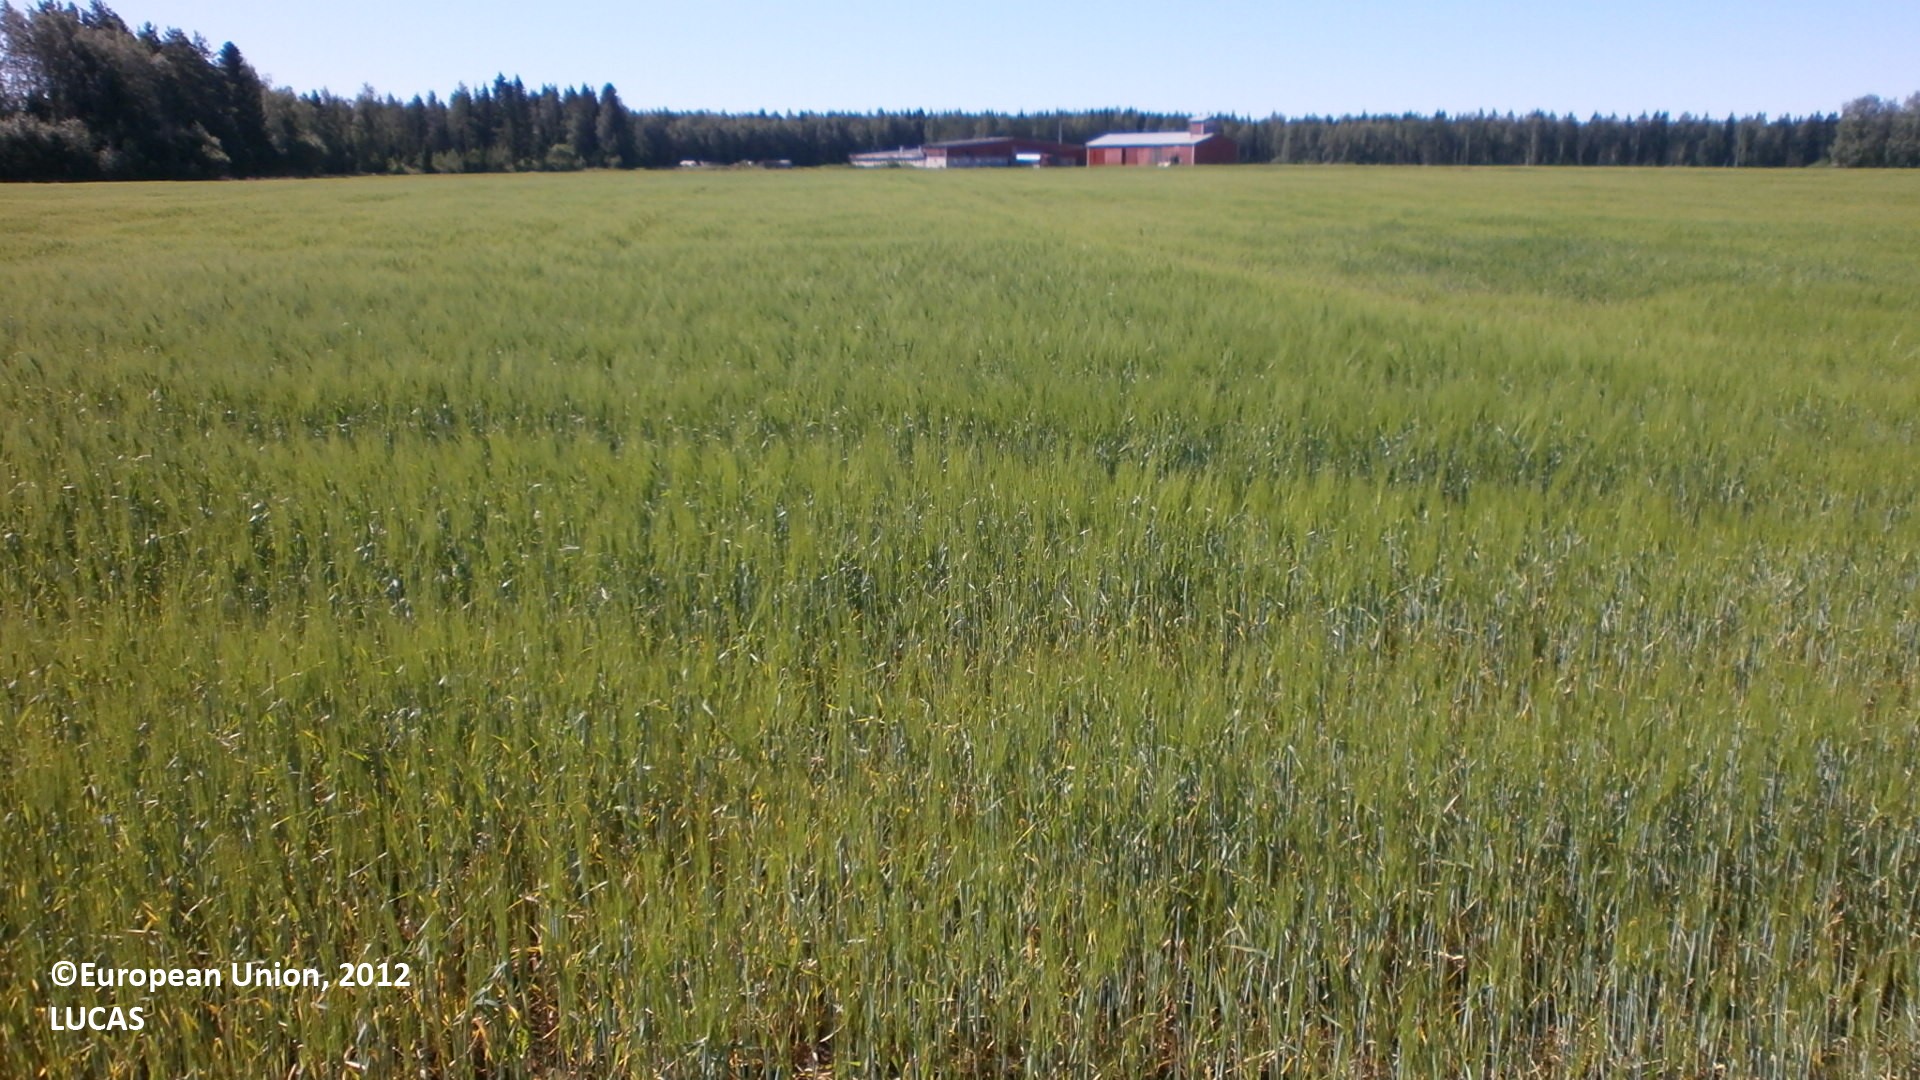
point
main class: Cropland
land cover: Barley
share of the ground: > 75 %
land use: Agriculture (excluding fallow land and kitchen gardens)
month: July
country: FI
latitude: 64.1227
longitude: 23.7992
